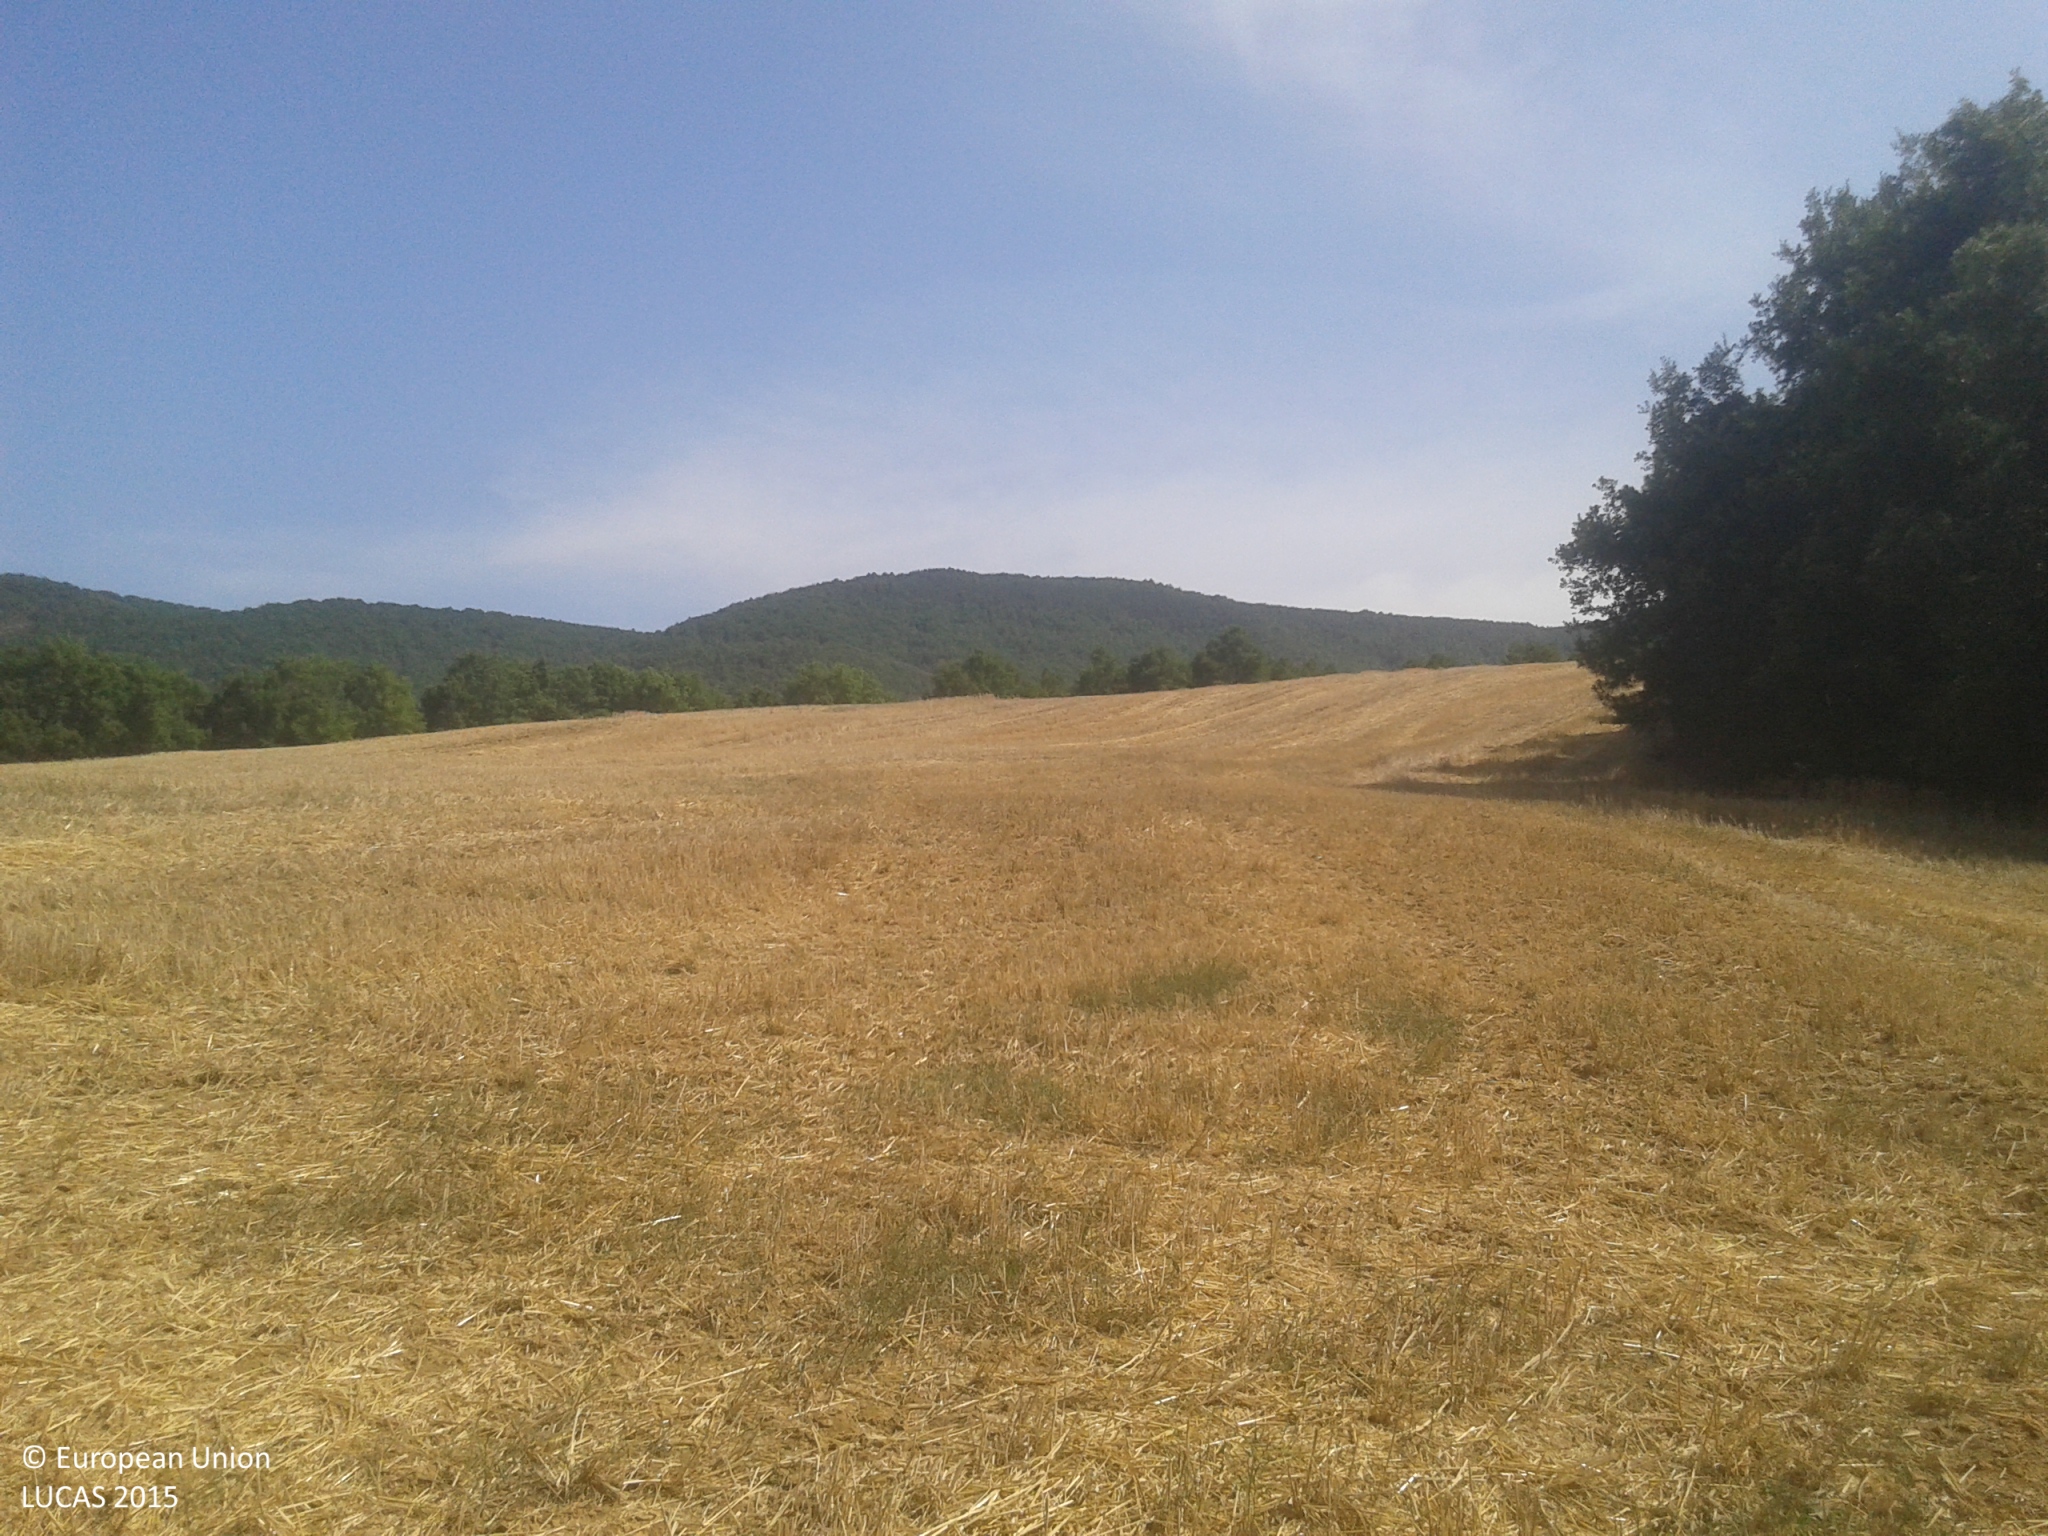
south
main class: Cropland
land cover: Common wheat
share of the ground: < 10 %
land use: Agriculture (excluding fallow land and kitchen gardens)
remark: Harvested field
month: July
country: ES
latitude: 42.0579
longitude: 1.0563
